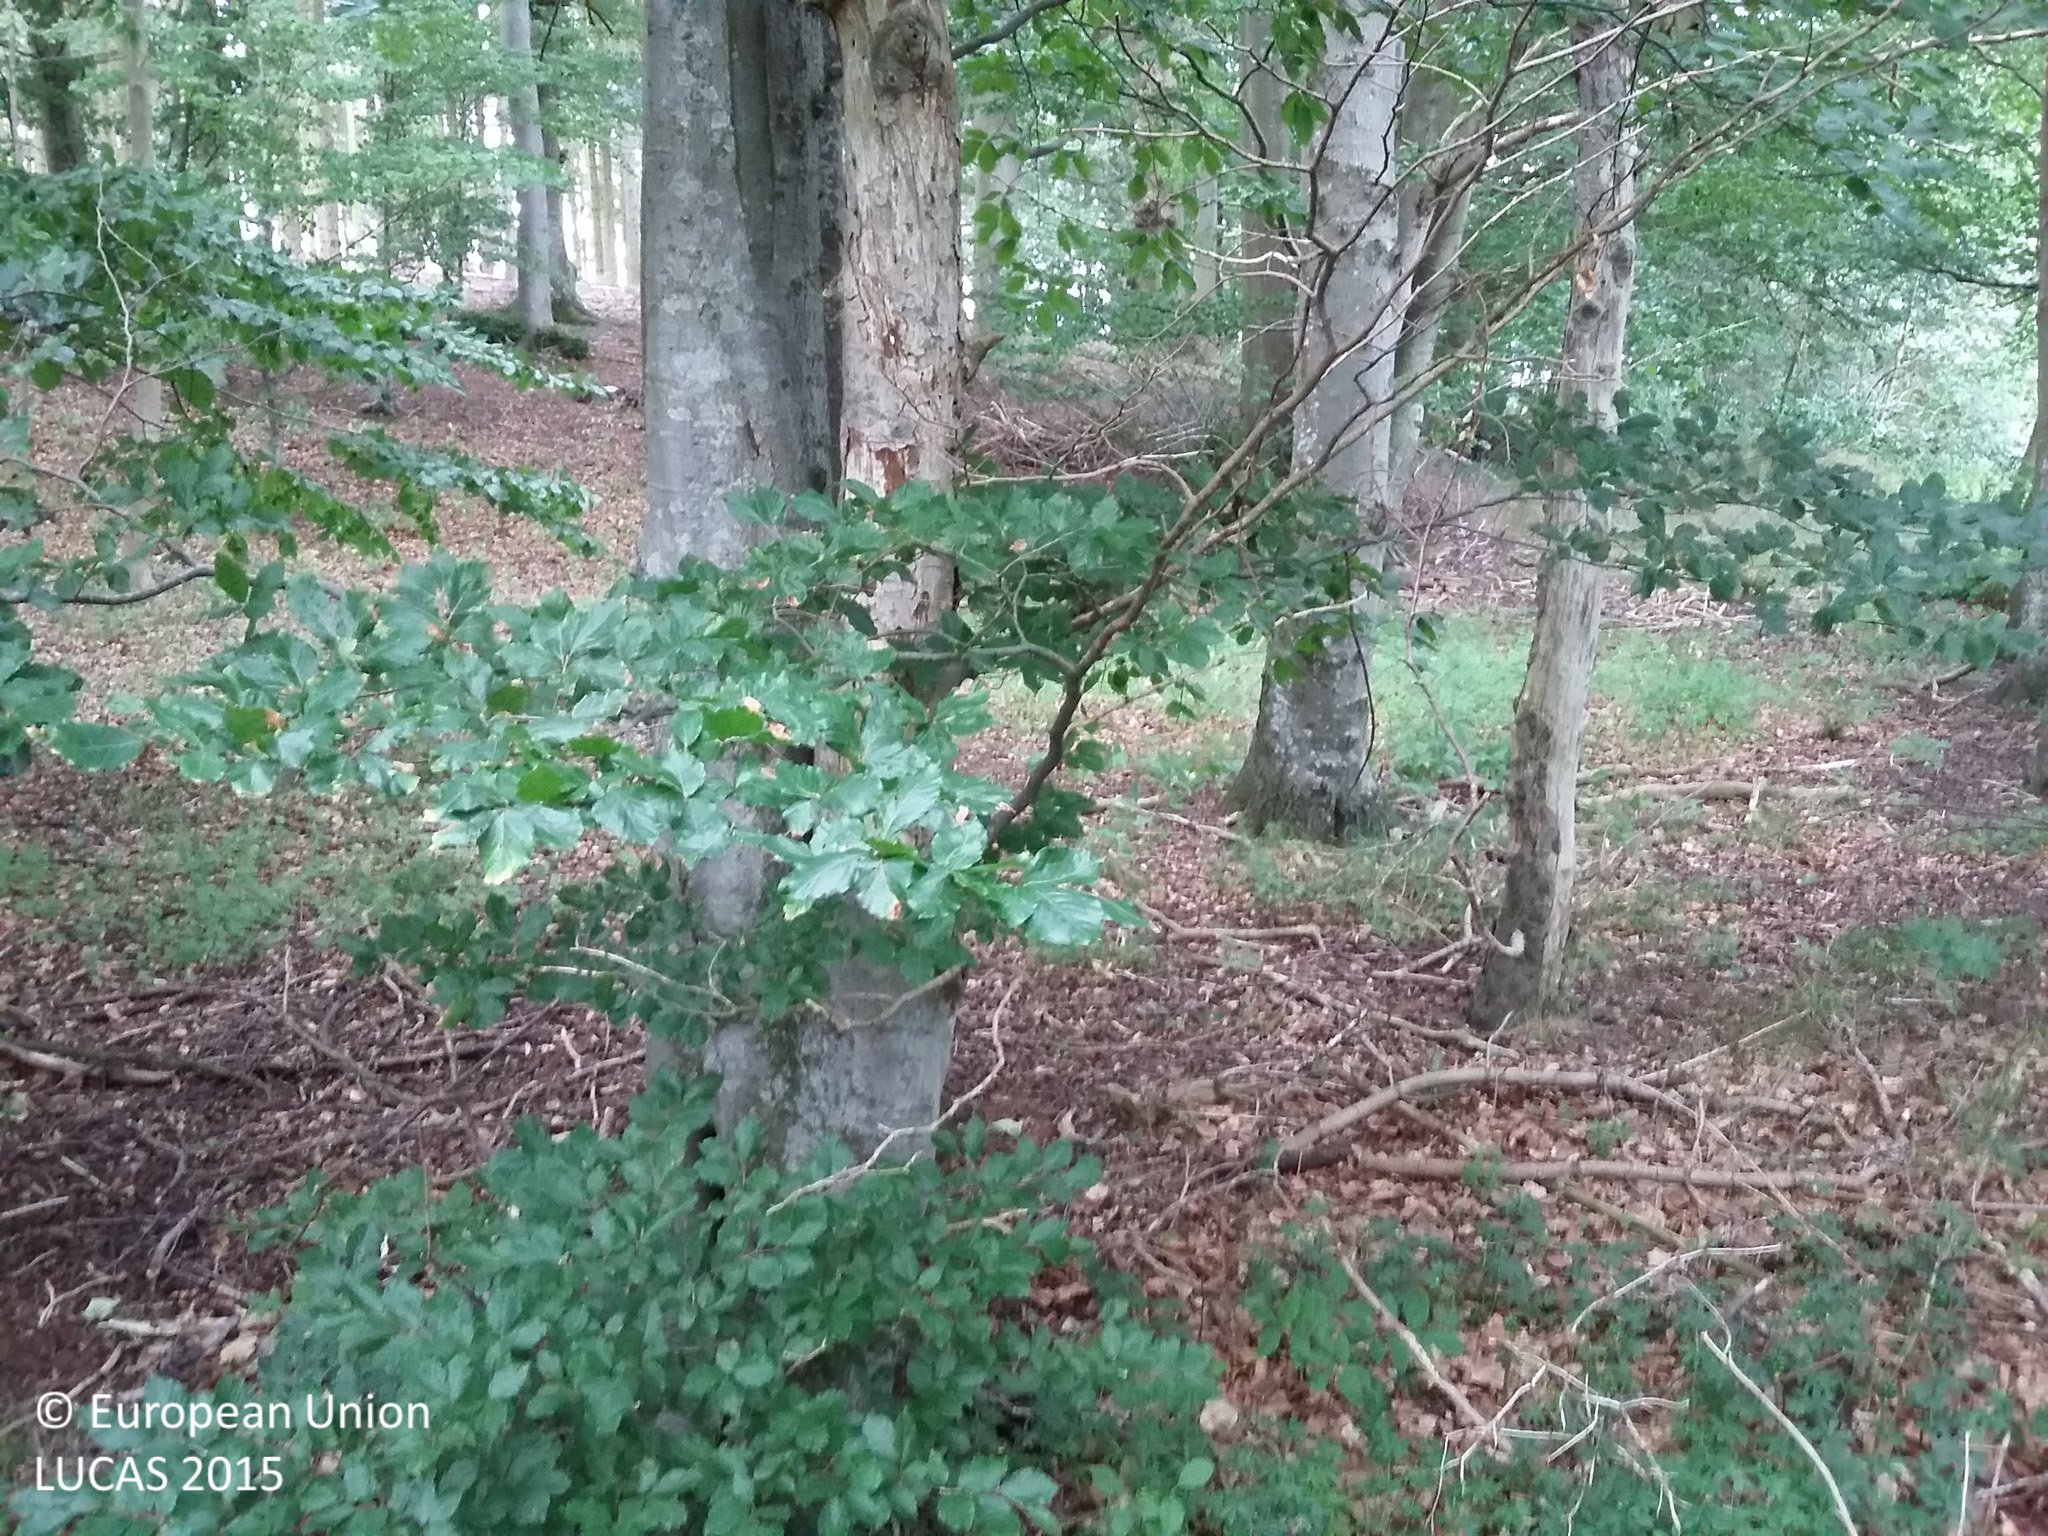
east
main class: Woodland
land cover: Broadleaved woodland
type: beech forest
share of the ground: > 75 %
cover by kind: broadleaved forest trees 90 %, herbaceous plants 5 %, unconsolidated bare surface 5 %
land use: Forestry
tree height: > 5 m
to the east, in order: Broadleaved woodland; Spruce dominated coniferous woodland; Grassland without tree/shrub cover; Broadleaved woodland; Tracks; Fences; Broadleaved woodland
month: August
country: DK
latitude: 55.5101
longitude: 11.7878
